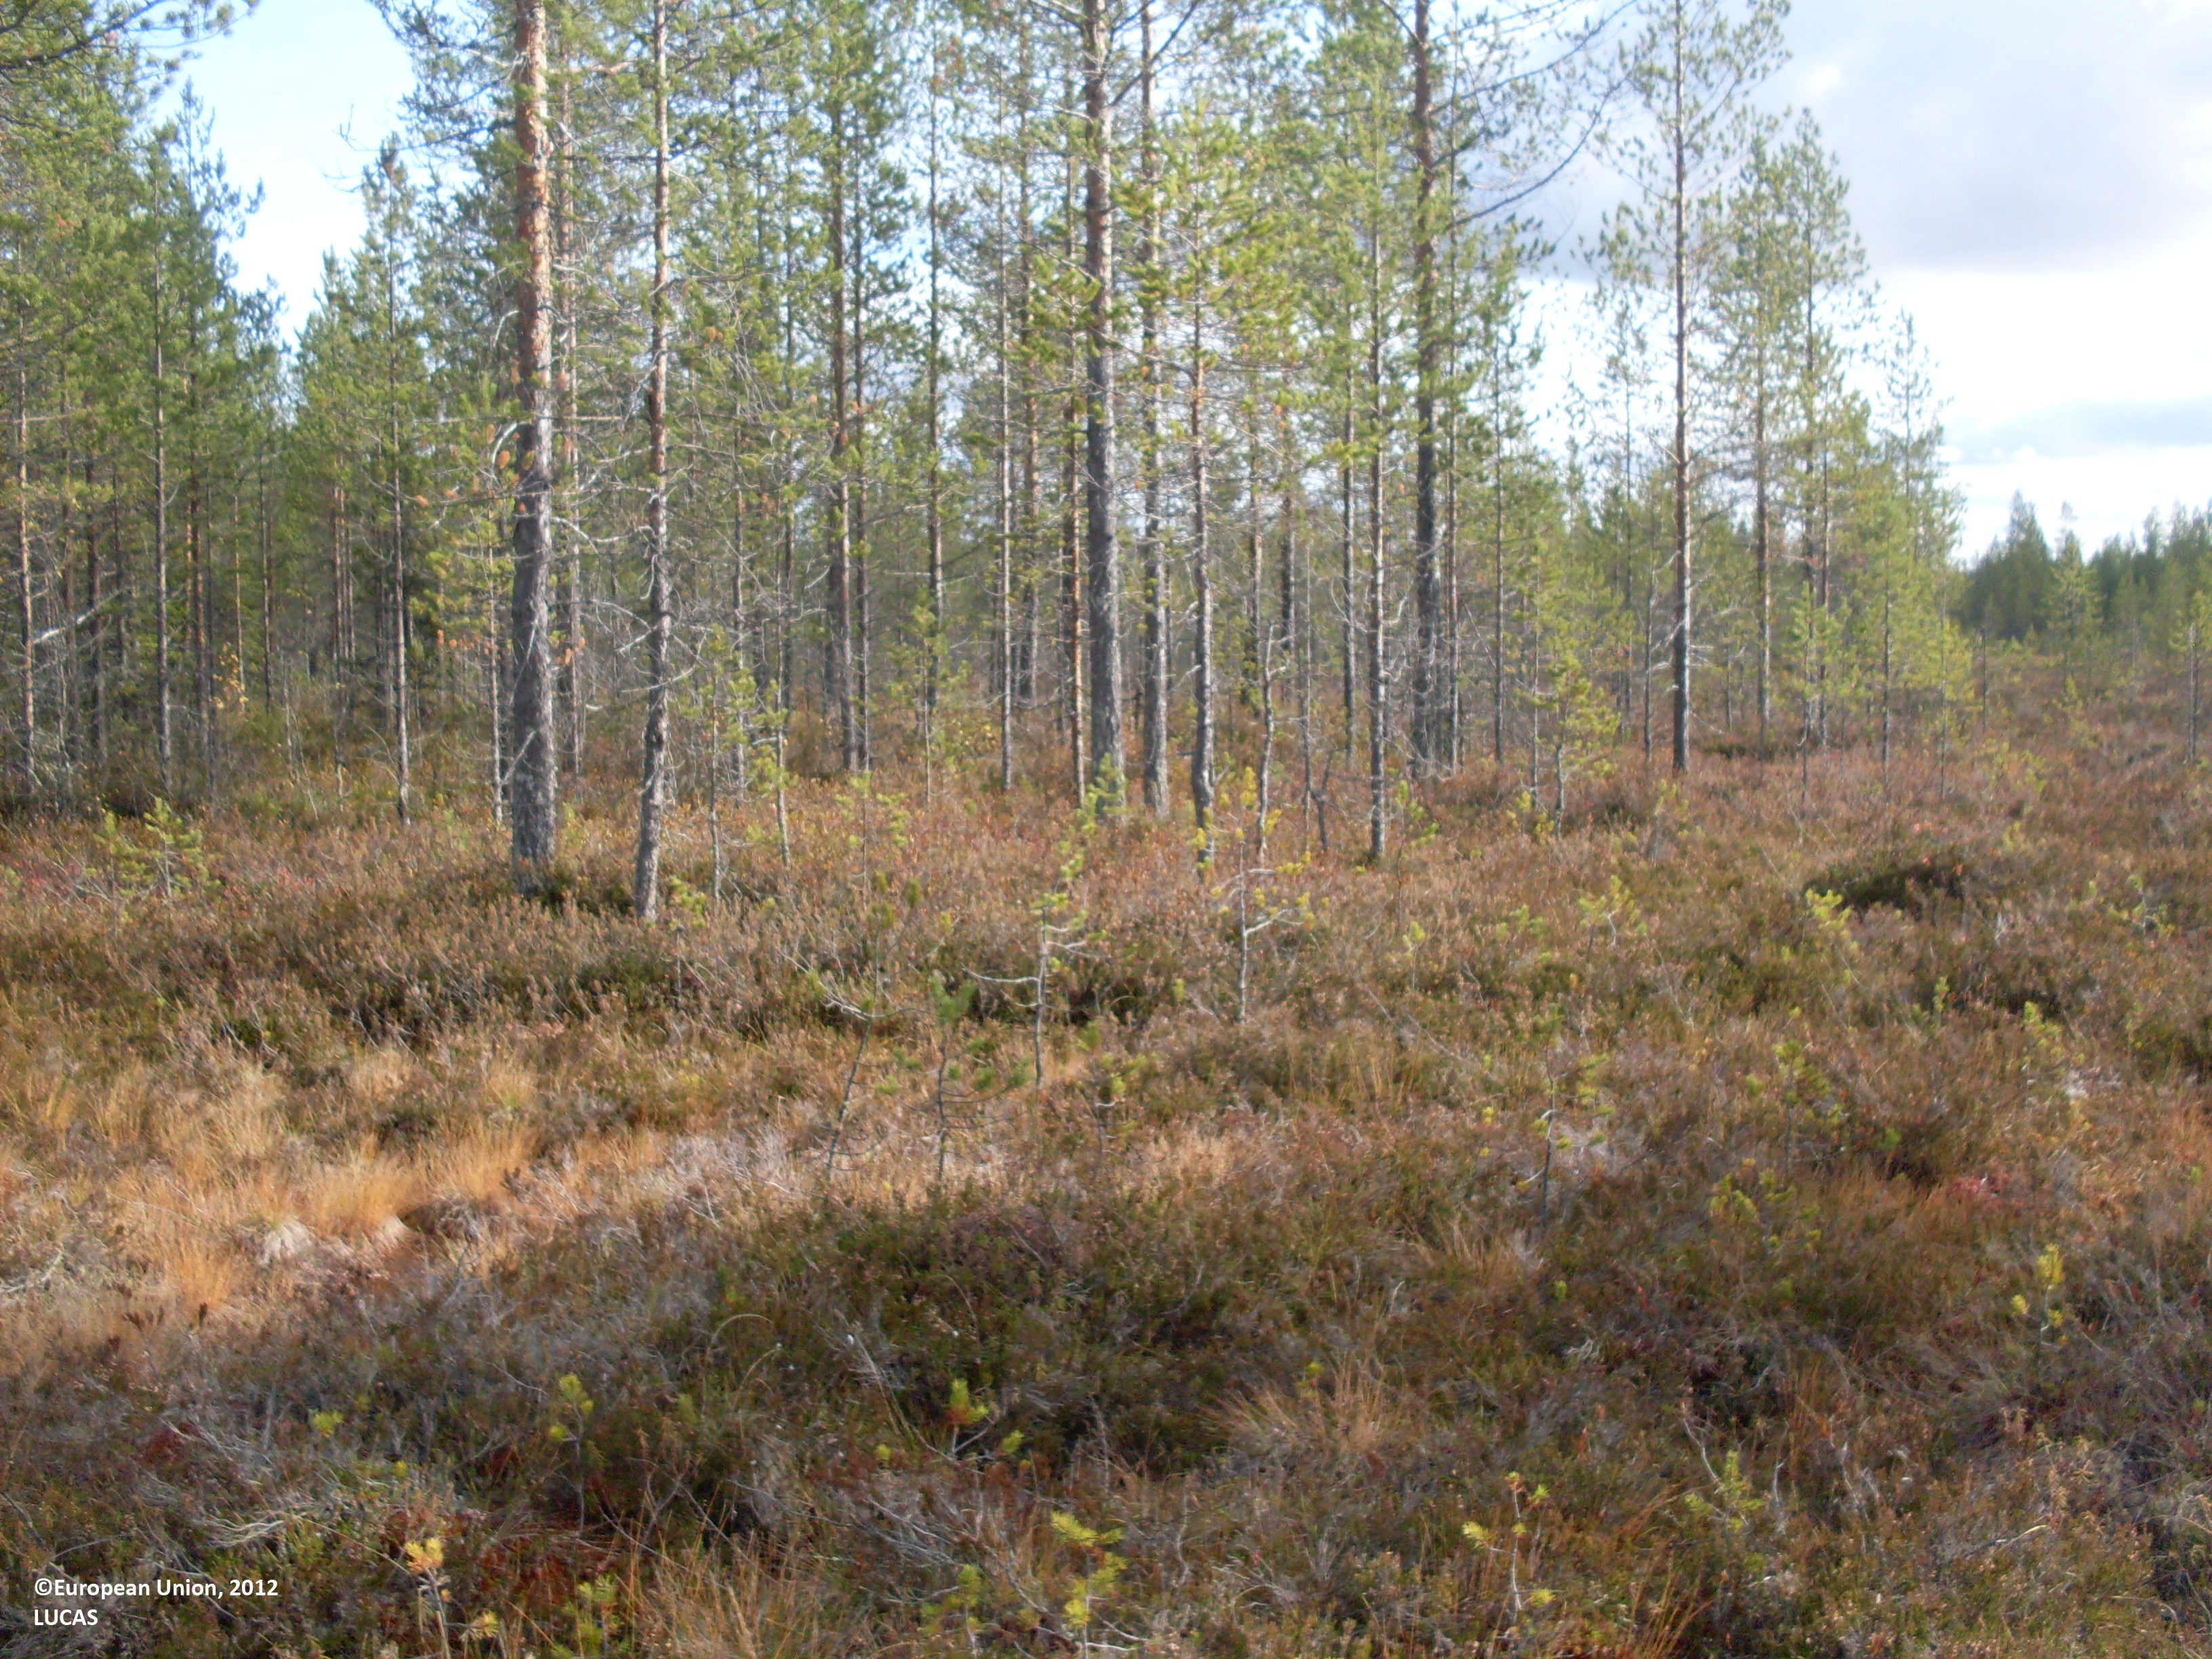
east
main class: Woodland
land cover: Pine dominated coniferous woodland
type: boreal forest
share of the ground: 10 - 25 %
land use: Forestry
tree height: > 5 m
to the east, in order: Pine dominated coniferous woodland; Ditches and canals; Pine dominated coniferous woodland; Ditches and canals; Peatbogs; Ditches and canals; Pine dominated coniferous woodland
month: September
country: FI
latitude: 64.7906
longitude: 29.4174
